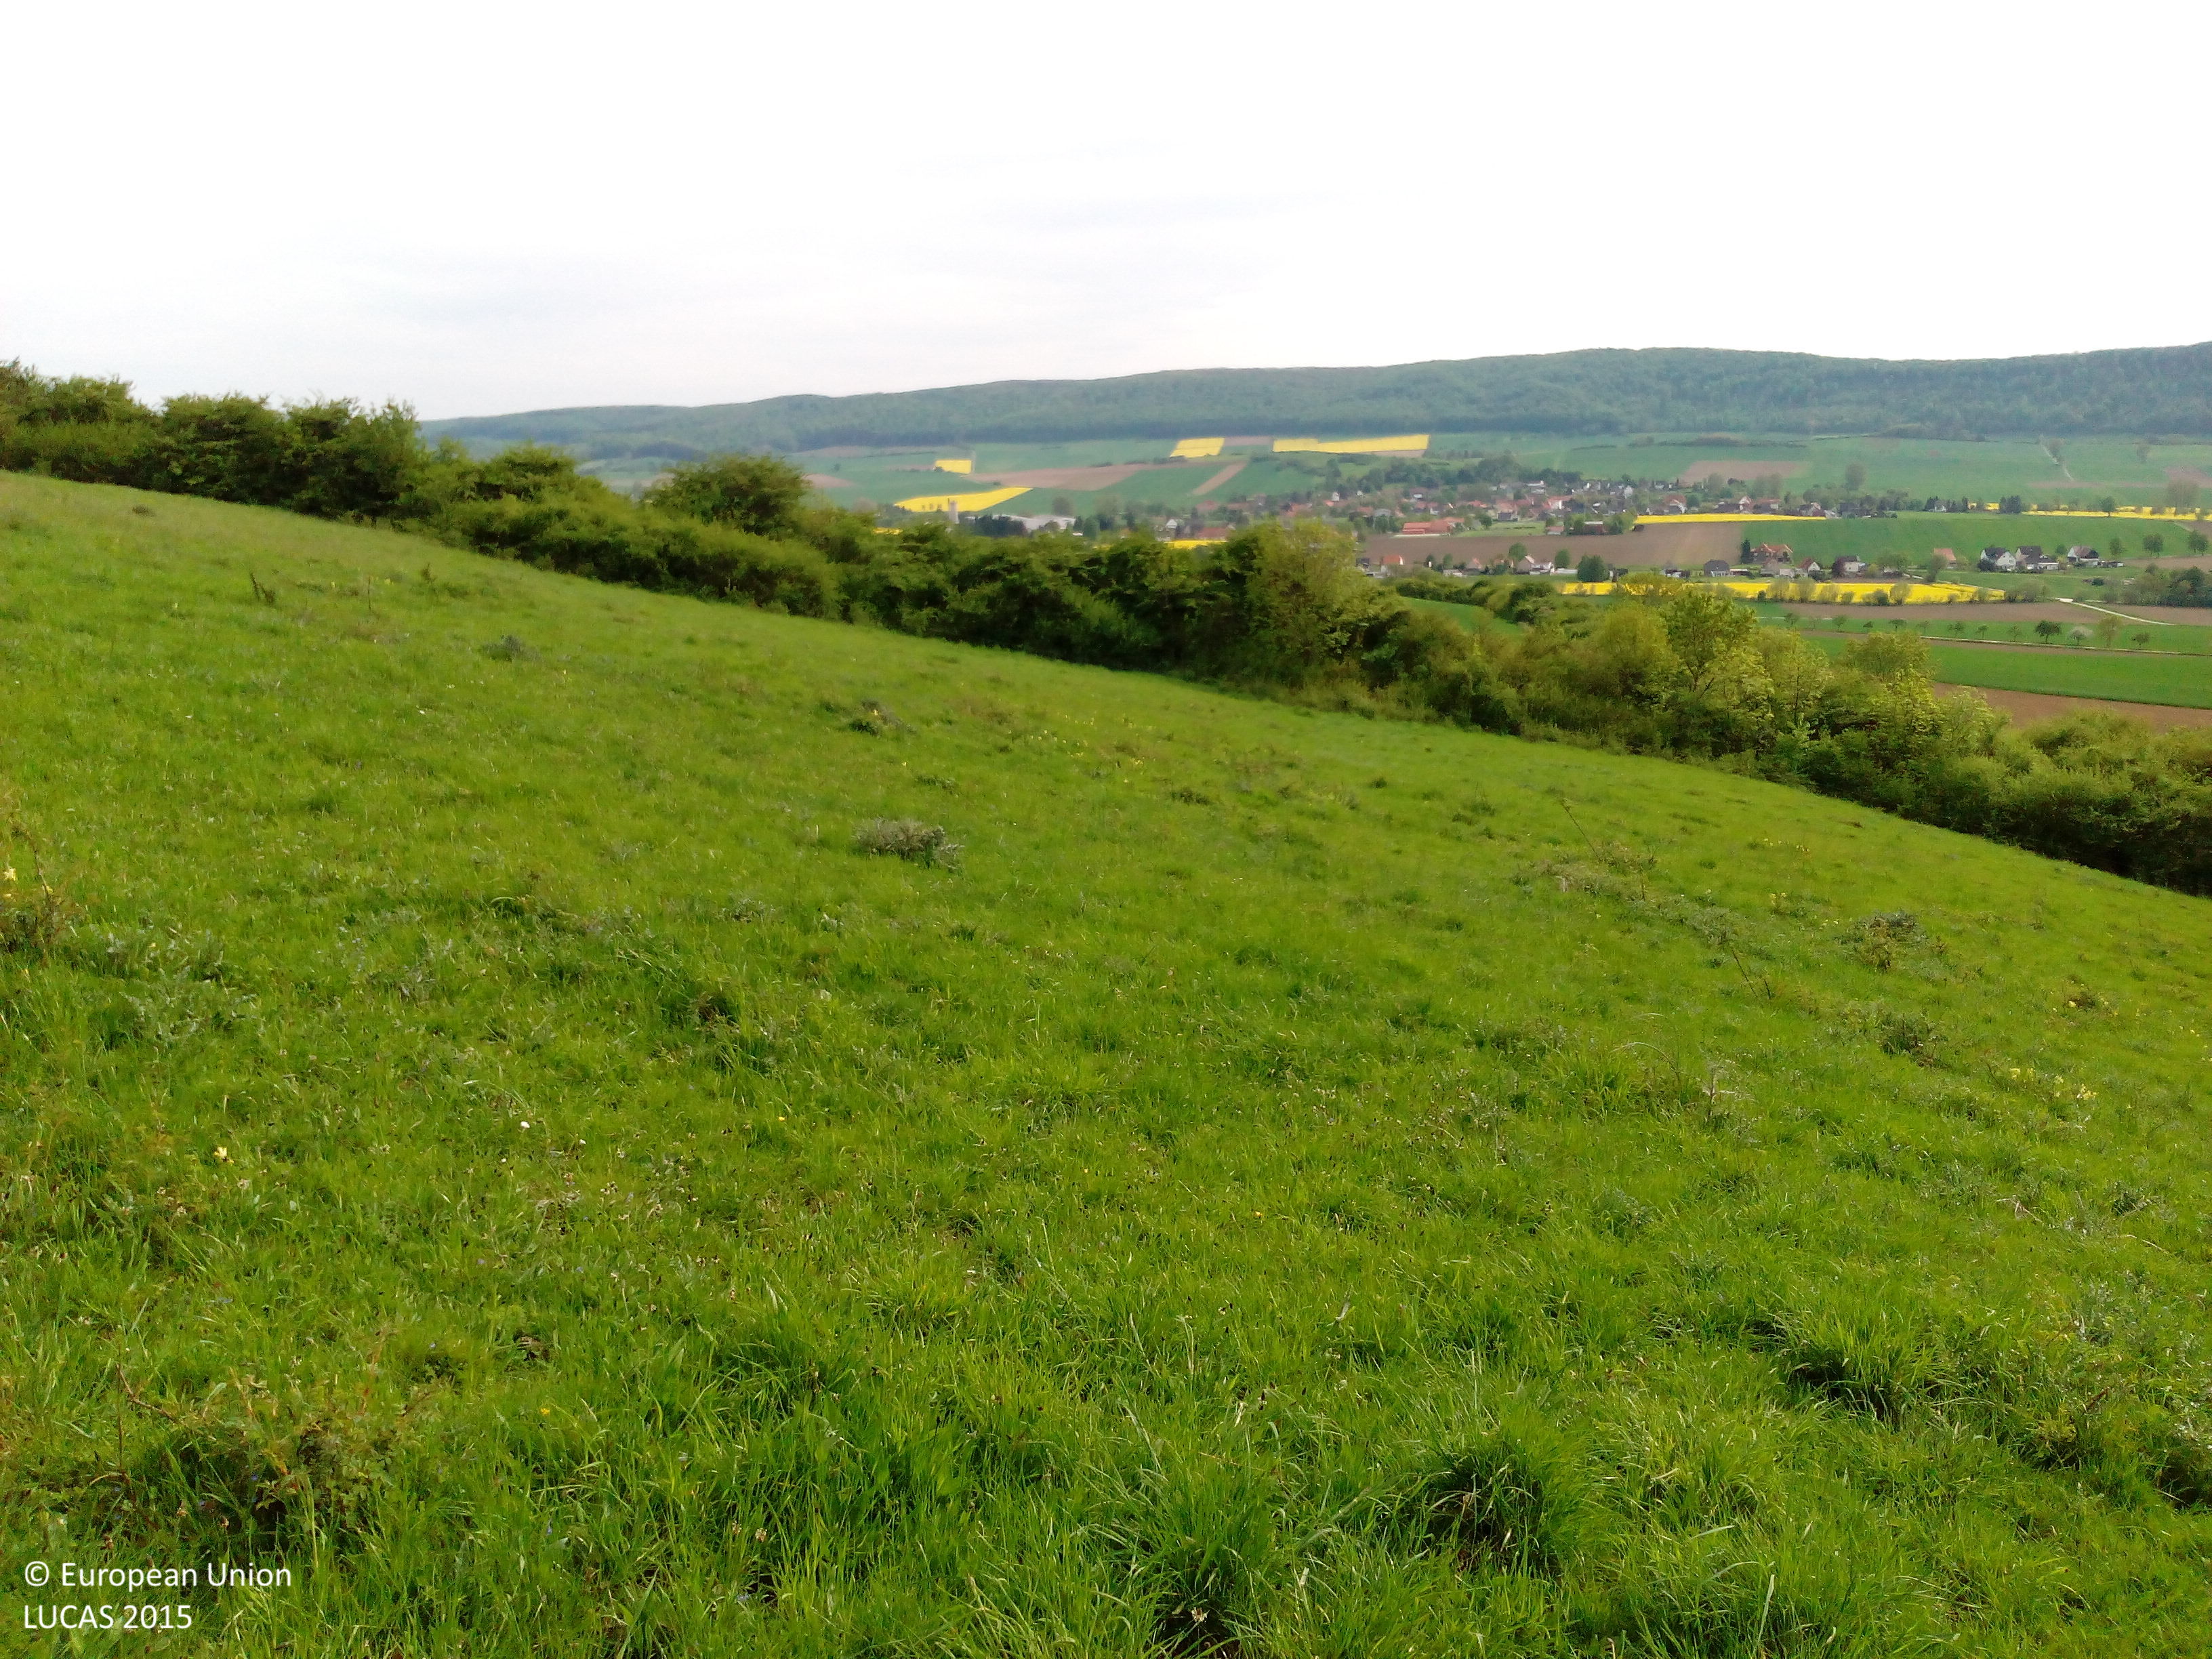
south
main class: Grassland
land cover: Grassland without tree/shrub cover
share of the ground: > 75 %
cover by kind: herbaceous plants 100 %
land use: Agriculture (excluding fallow land and kitchen gardens)
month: May
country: DE
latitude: 52.0354
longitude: 9.6357
